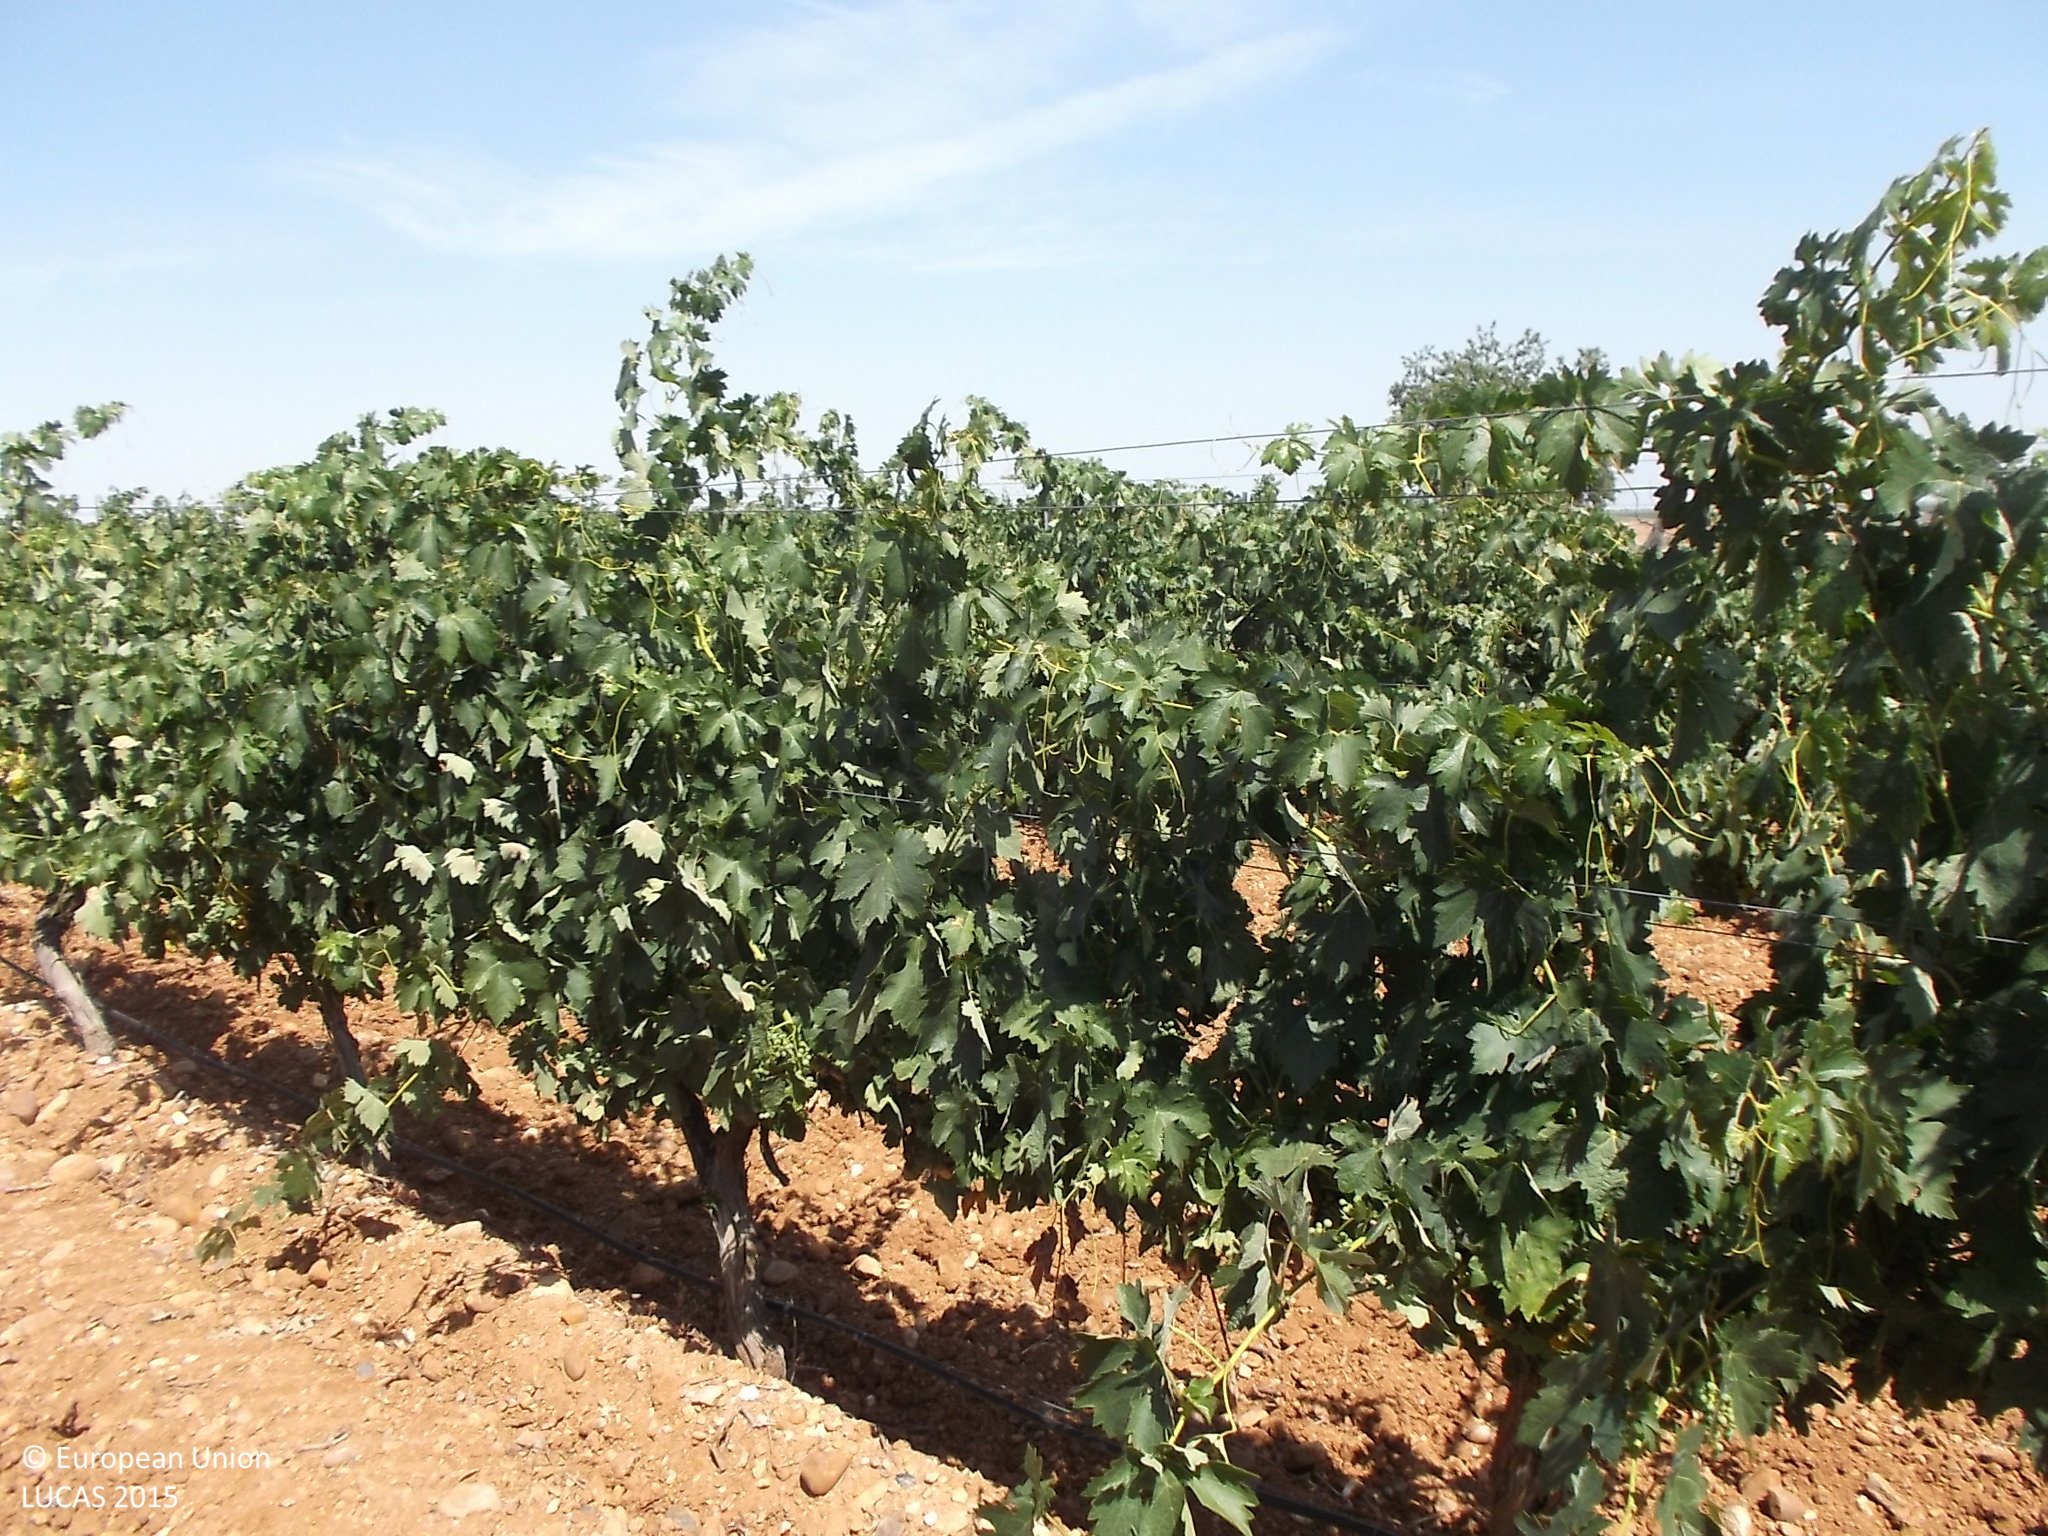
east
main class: Cropland
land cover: Vineyards
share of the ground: 10 - 25 %
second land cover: Other bare soil
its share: > 75 %
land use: Agriculture (excluding fallow land and kitchen gardens)
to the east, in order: Vineyards; Other bare soil; Grassland without tree/shrub cover; Grassland with sparse tree/shrub cover; Tracks; Vineyards; Grassland with sparse tree/shrub cover; Tracks; Vineyards
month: July
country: ES
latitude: 41.4837
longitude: -5.2995
